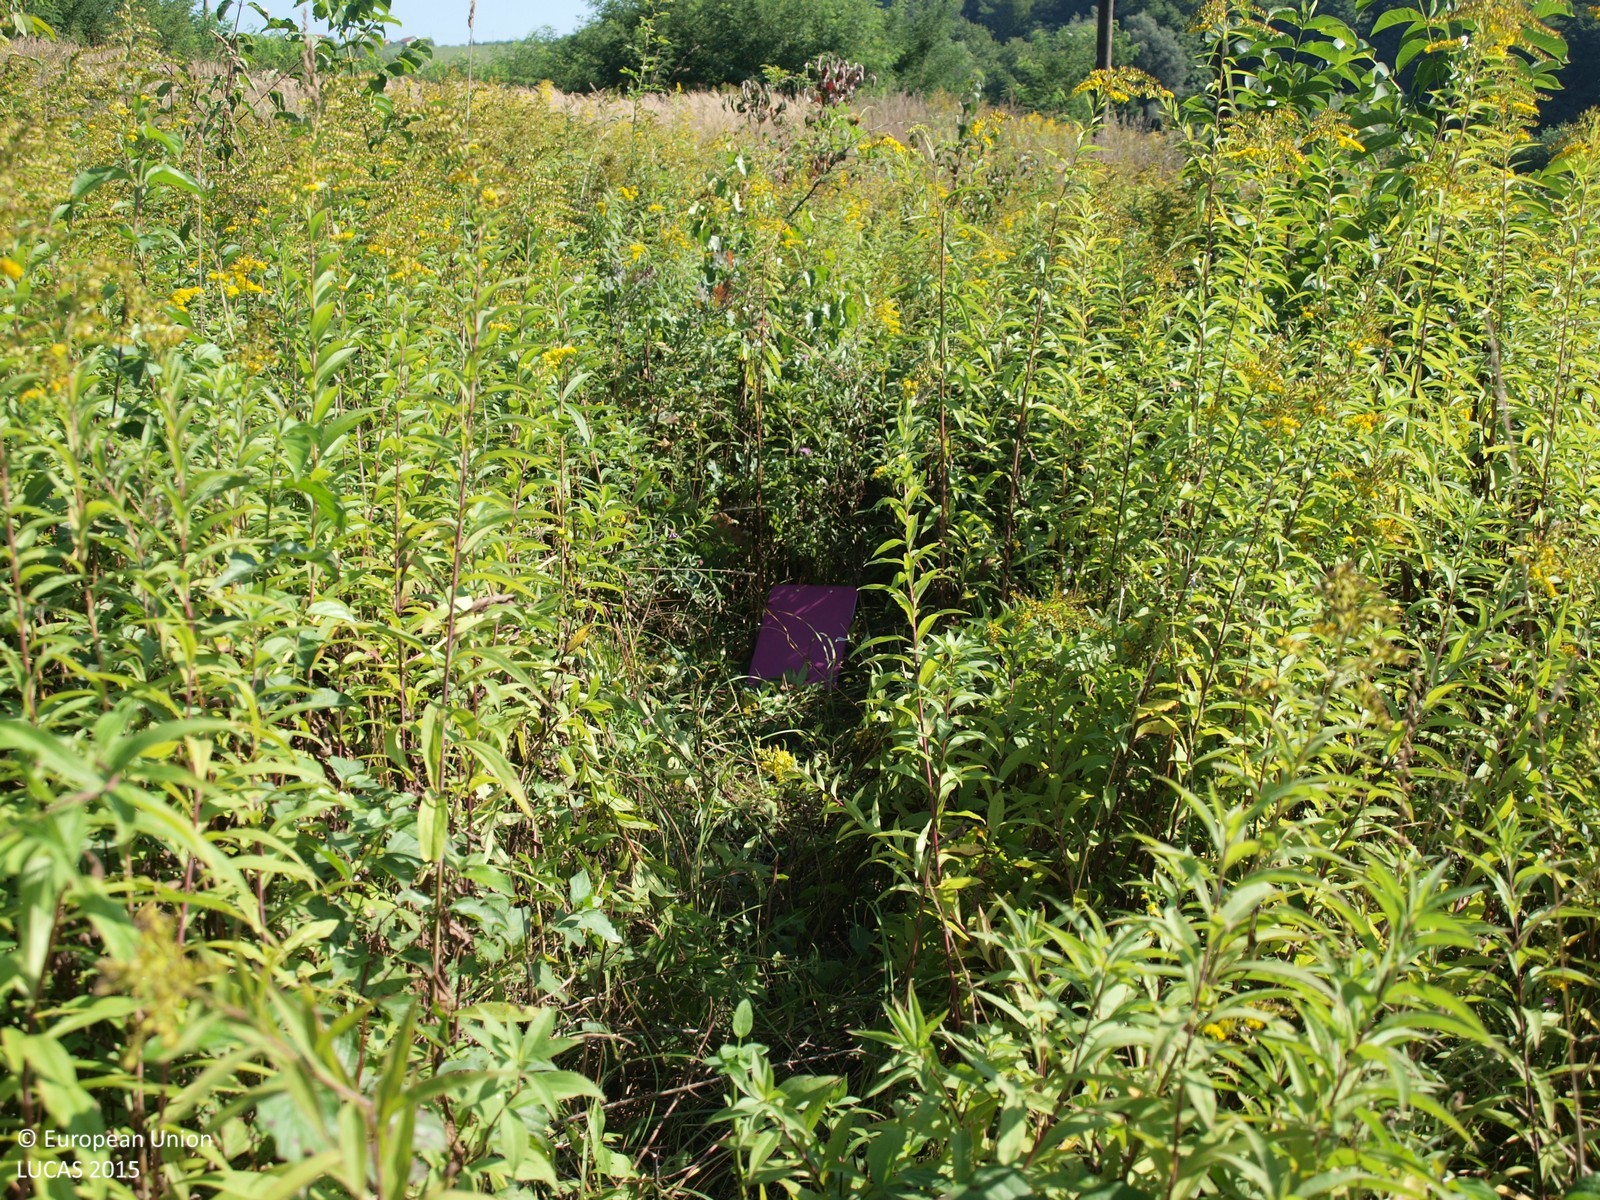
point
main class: Shrubland
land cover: Shrubland with sparse tree cover
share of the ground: > 75 %
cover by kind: shrubs 95 %, broadleaved forest trees 5 %
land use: Semi-natural and natural areas not in use
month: August
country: HR
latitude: 46.0909
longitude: 16.6353
